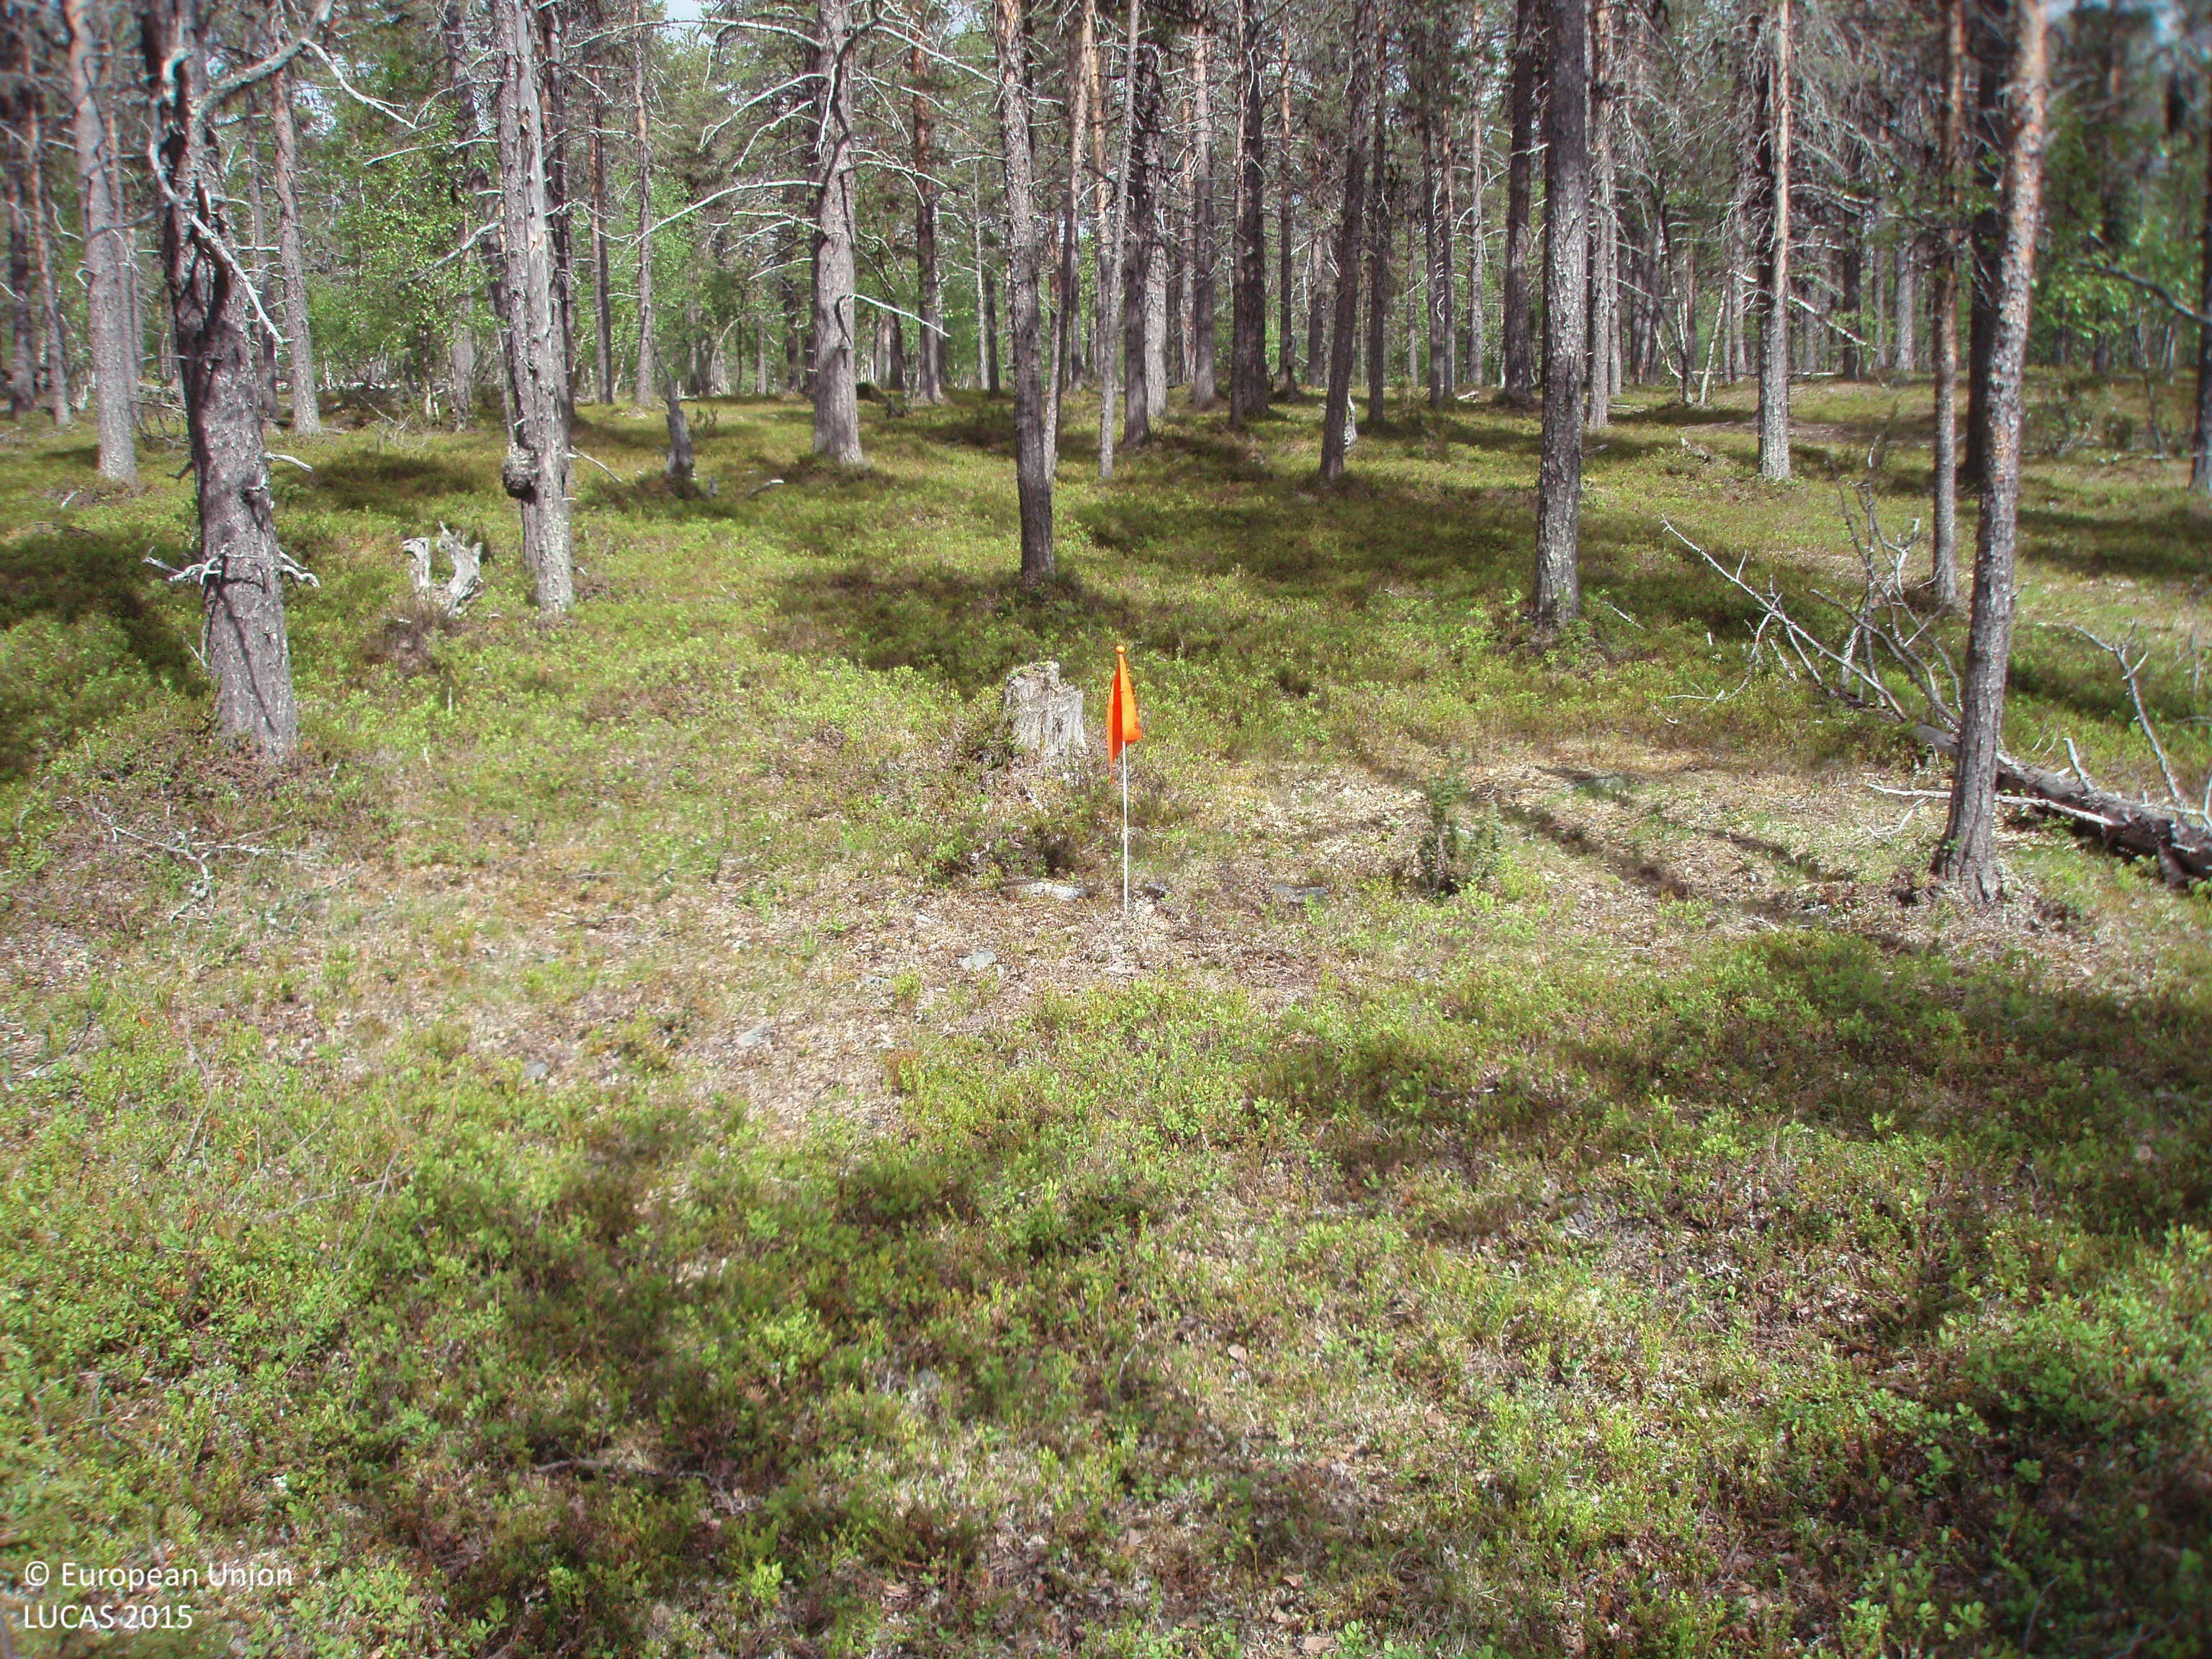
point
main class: Woodland
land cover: Pine dominated coniferous woodland
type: boreal forest
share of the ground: > 75 %
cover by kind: coniferous forest trees 70 %, shrubs 20 %, broadleaved forest trees 10 %
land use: Forestry
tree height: > 5 m
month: June
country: FI
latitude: 68.4322
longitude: 25.9115
